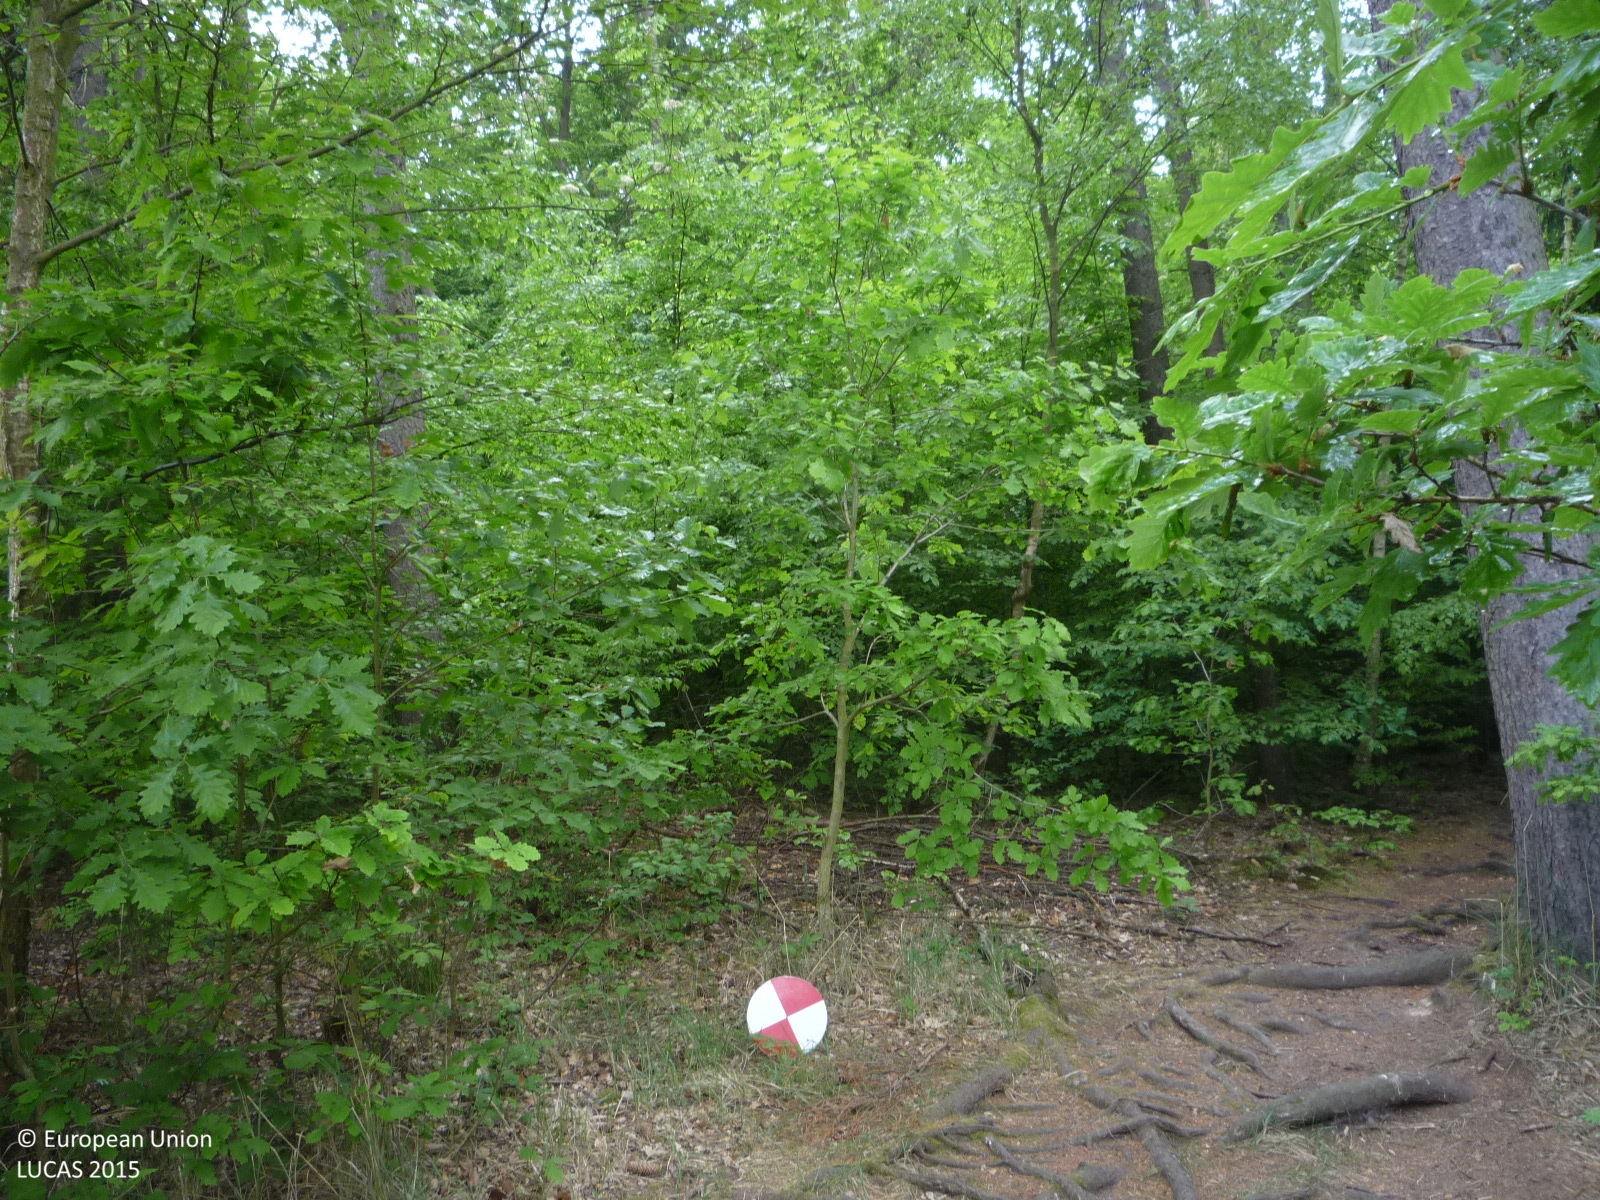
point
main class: Woodland
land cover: Spruce dominated mixed woodland
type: hemiboreal forest and nemoral coniferous forest and mixed broadleaved-coniferous forest
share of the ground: > 75 %
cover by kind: coniferous forest trees 60 %, broadleaved forest trees 30 %, herbaceous plants 5 %, unconsolidated bare surface 5 %
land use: Forestry
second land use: Sport
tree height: > 5 m
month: May
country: CZ
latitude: 50.0241
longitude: 14.4822
